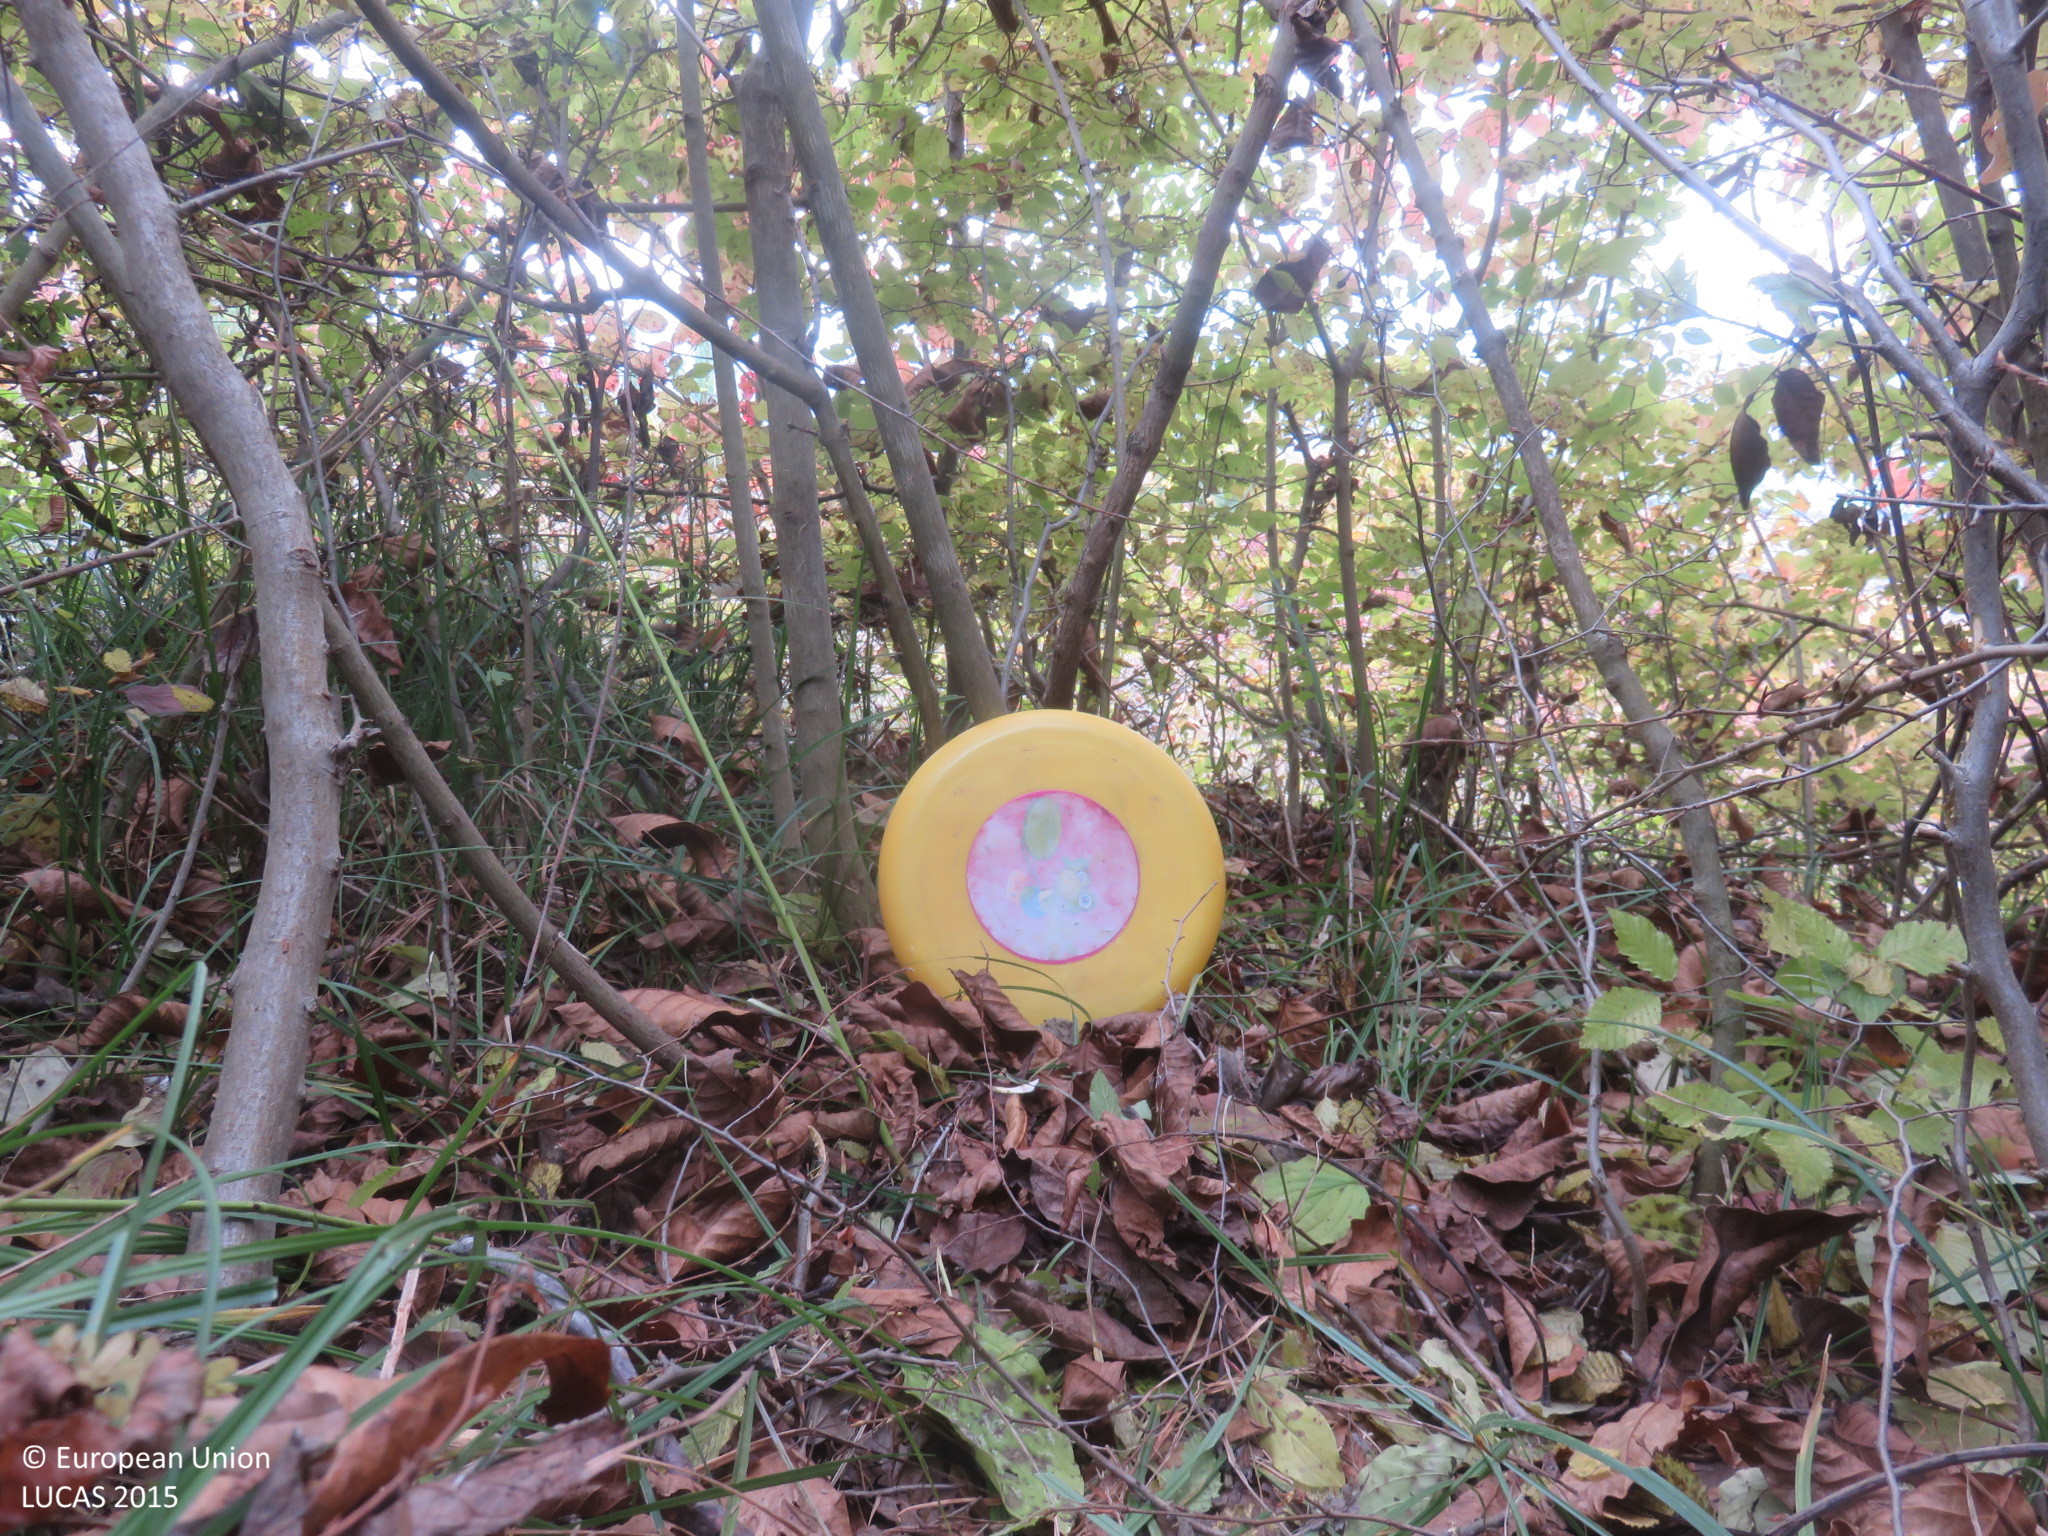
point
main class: Shrubland
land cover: Shrubland with sparse tree cover
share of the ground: > 75 %
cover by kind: shrubs 95 %, broadleaved forest trees 5 %
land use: Semi-natural and natural areas not in use
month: October
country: BG
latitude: 43.0044
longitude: 24.9455
